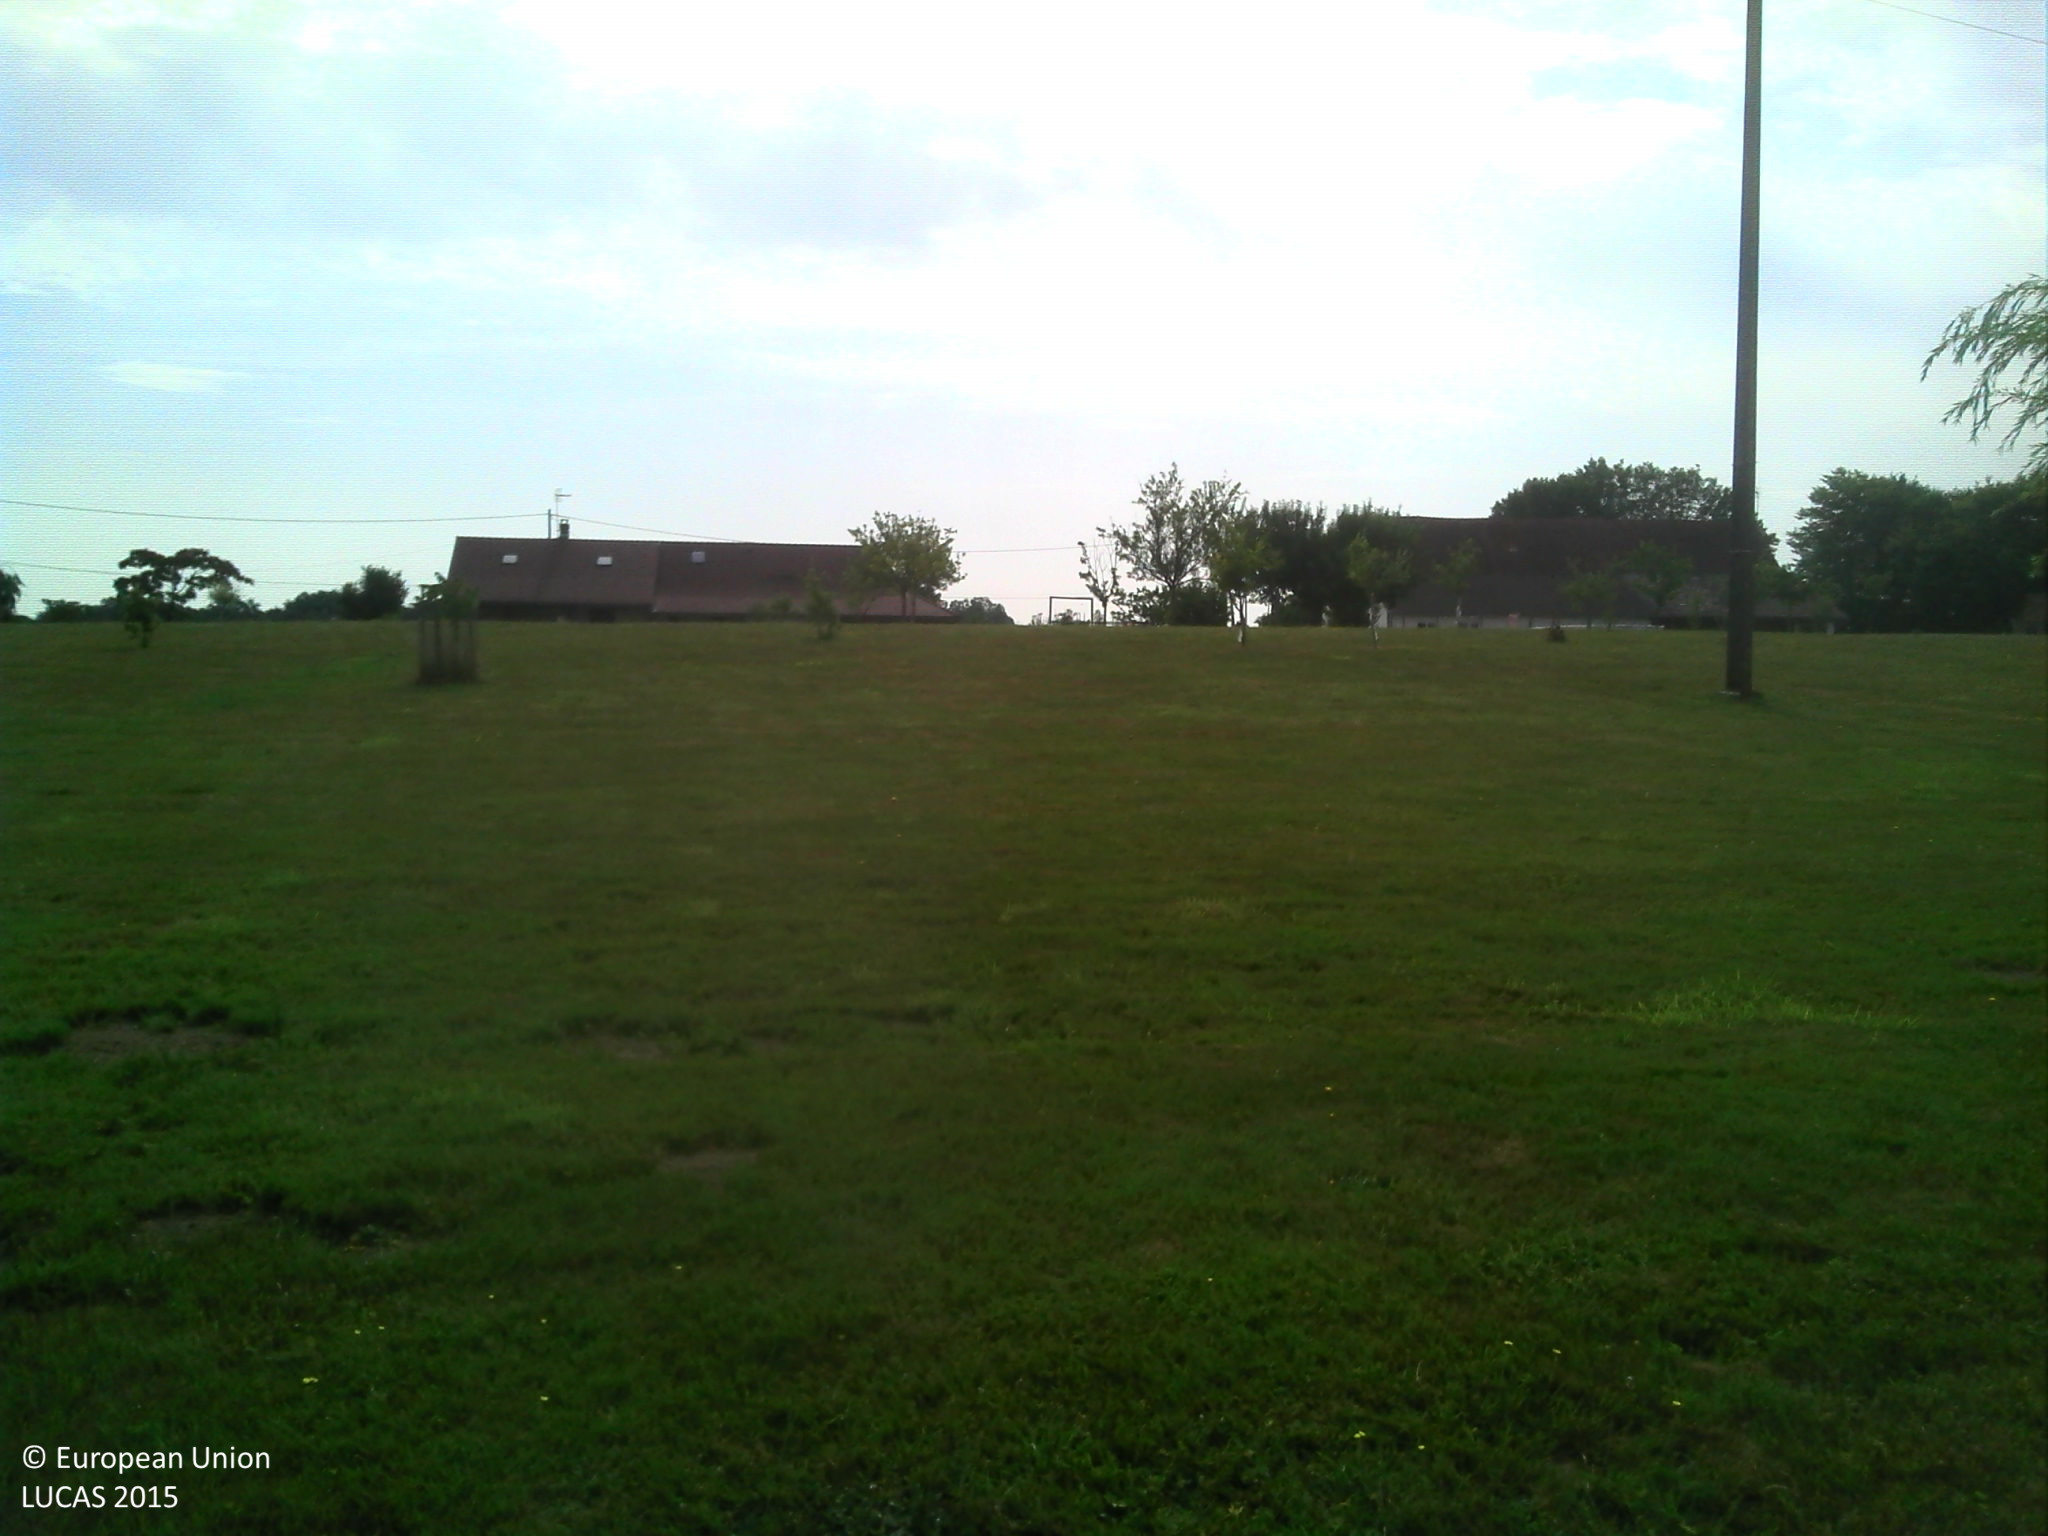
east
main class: Grassland
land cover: Grassland with sparse tree/shrub cover
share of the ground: > 75 %
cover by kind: herbaceous plants 95 %, broadleaved forest trees 5 %
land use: Residential
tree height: < 5 m
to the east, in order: Grassland with sparse tree/shrub cover; Electric lines; Grassland with sparse tree/shrub cover; Artificial constructions in urban areas; Grass margins; Ditches and canals; Soya
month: July
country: FR
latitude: 46.8834
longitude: 5.3957
